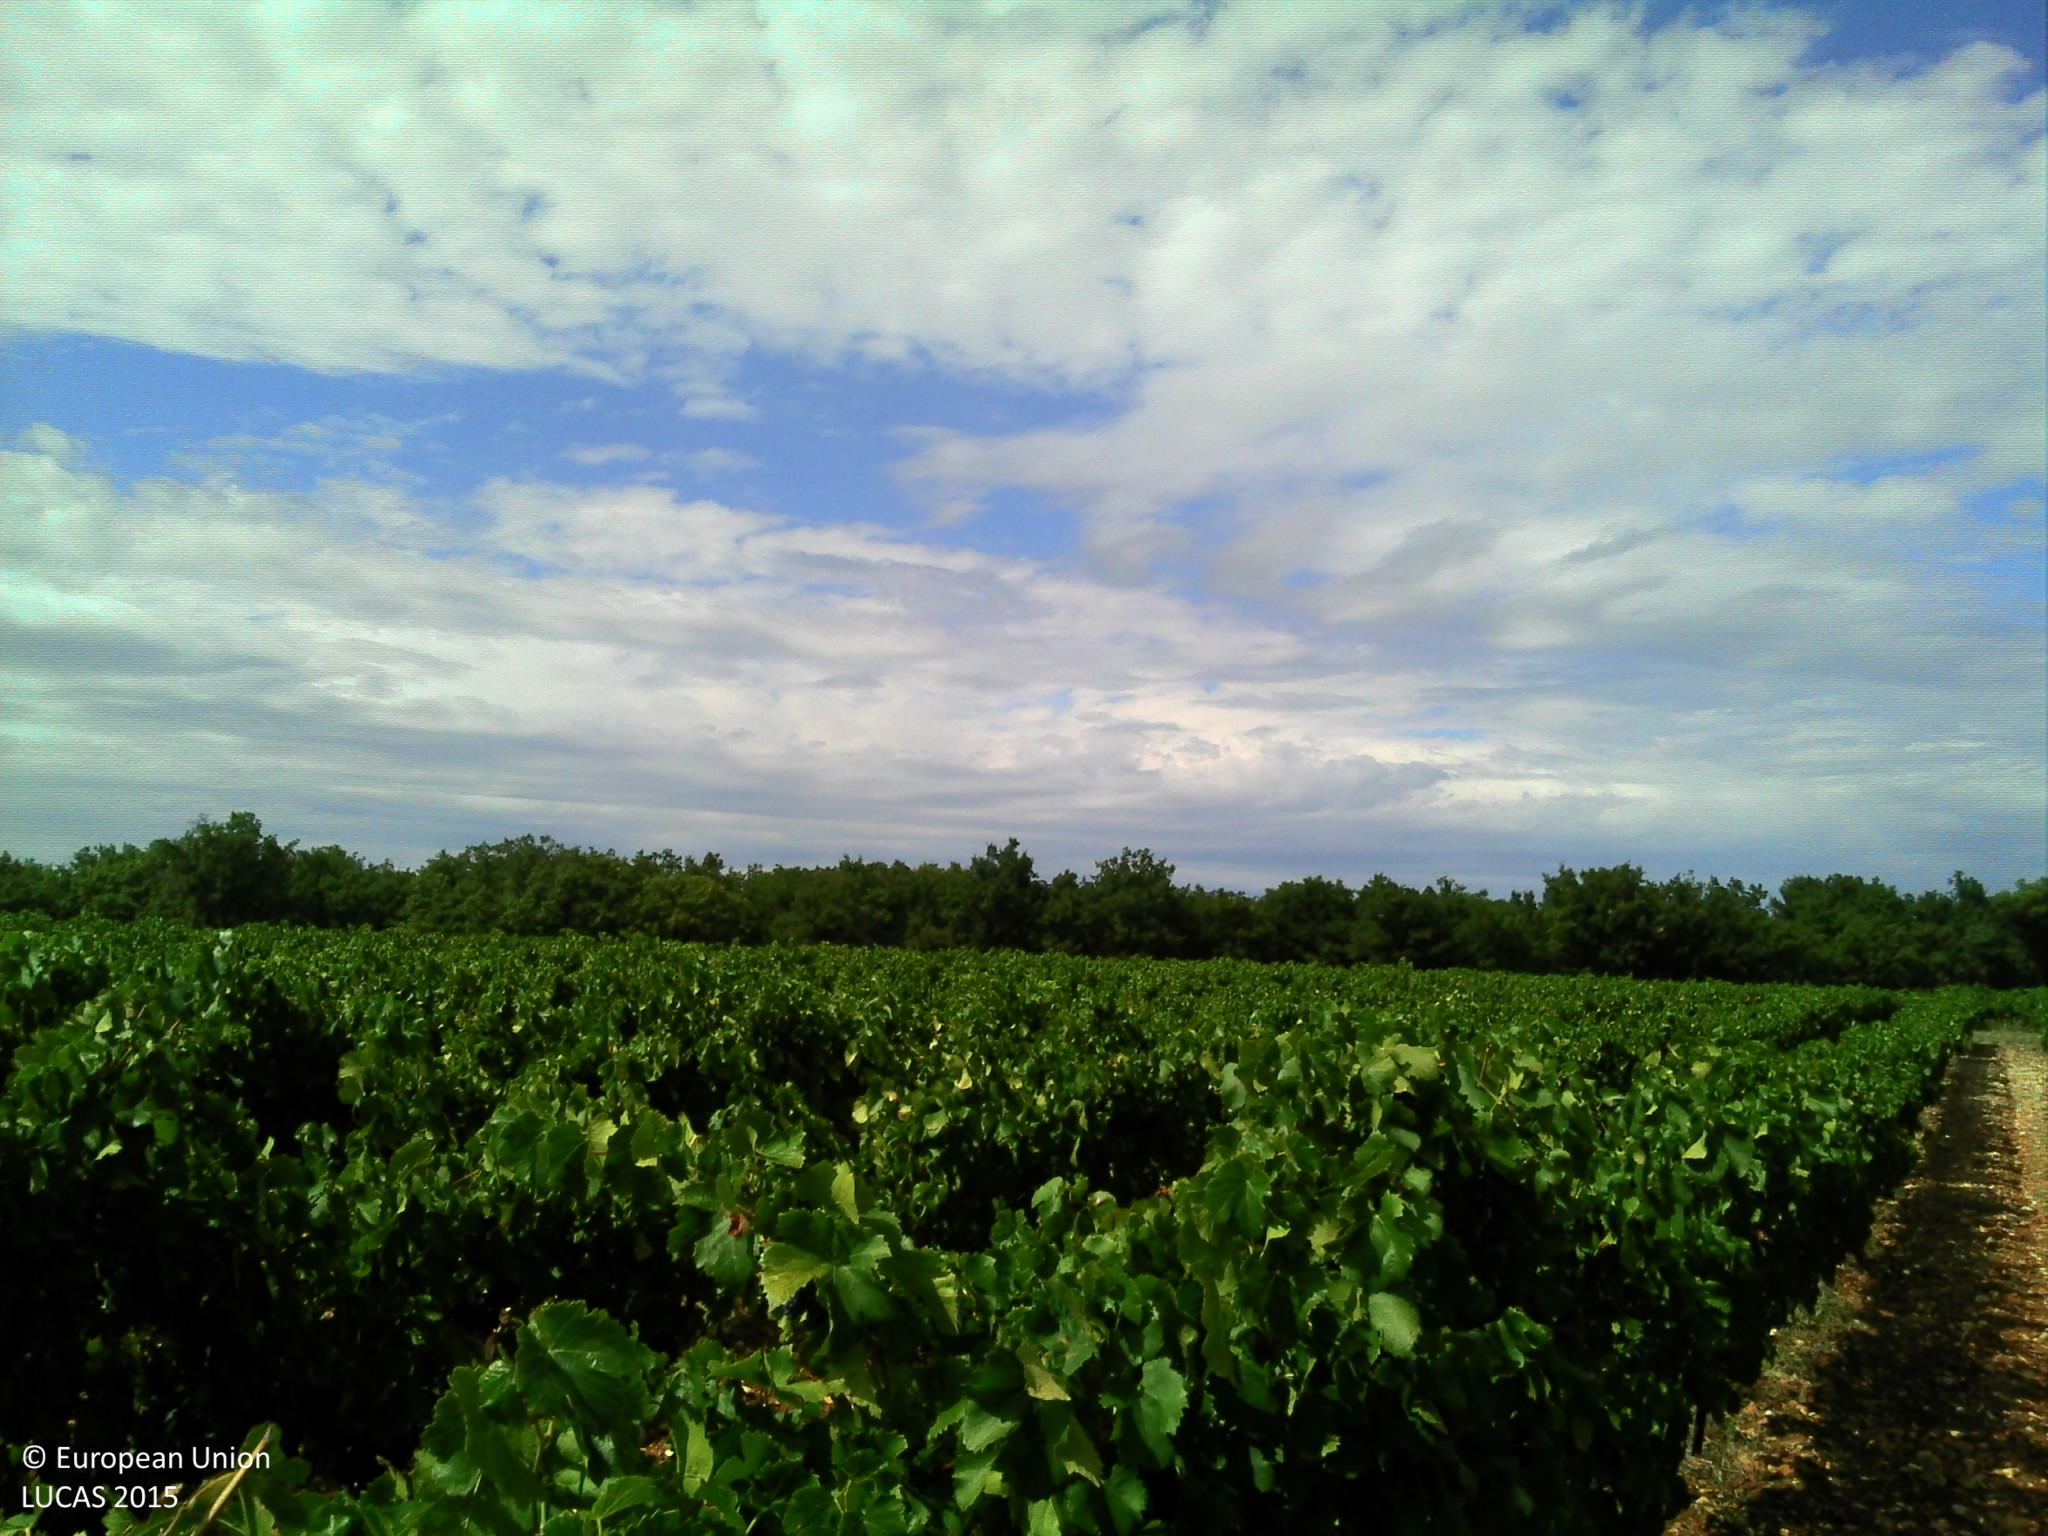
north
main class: Cropland
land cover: Vineyards
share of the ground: 10 - 25 %
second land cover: Other bare soil
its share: > 75 %
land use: Agriculture (excluding fallow land and kitchen gardens)
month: September
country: FR
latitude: 44.3206
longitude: 5.0046
